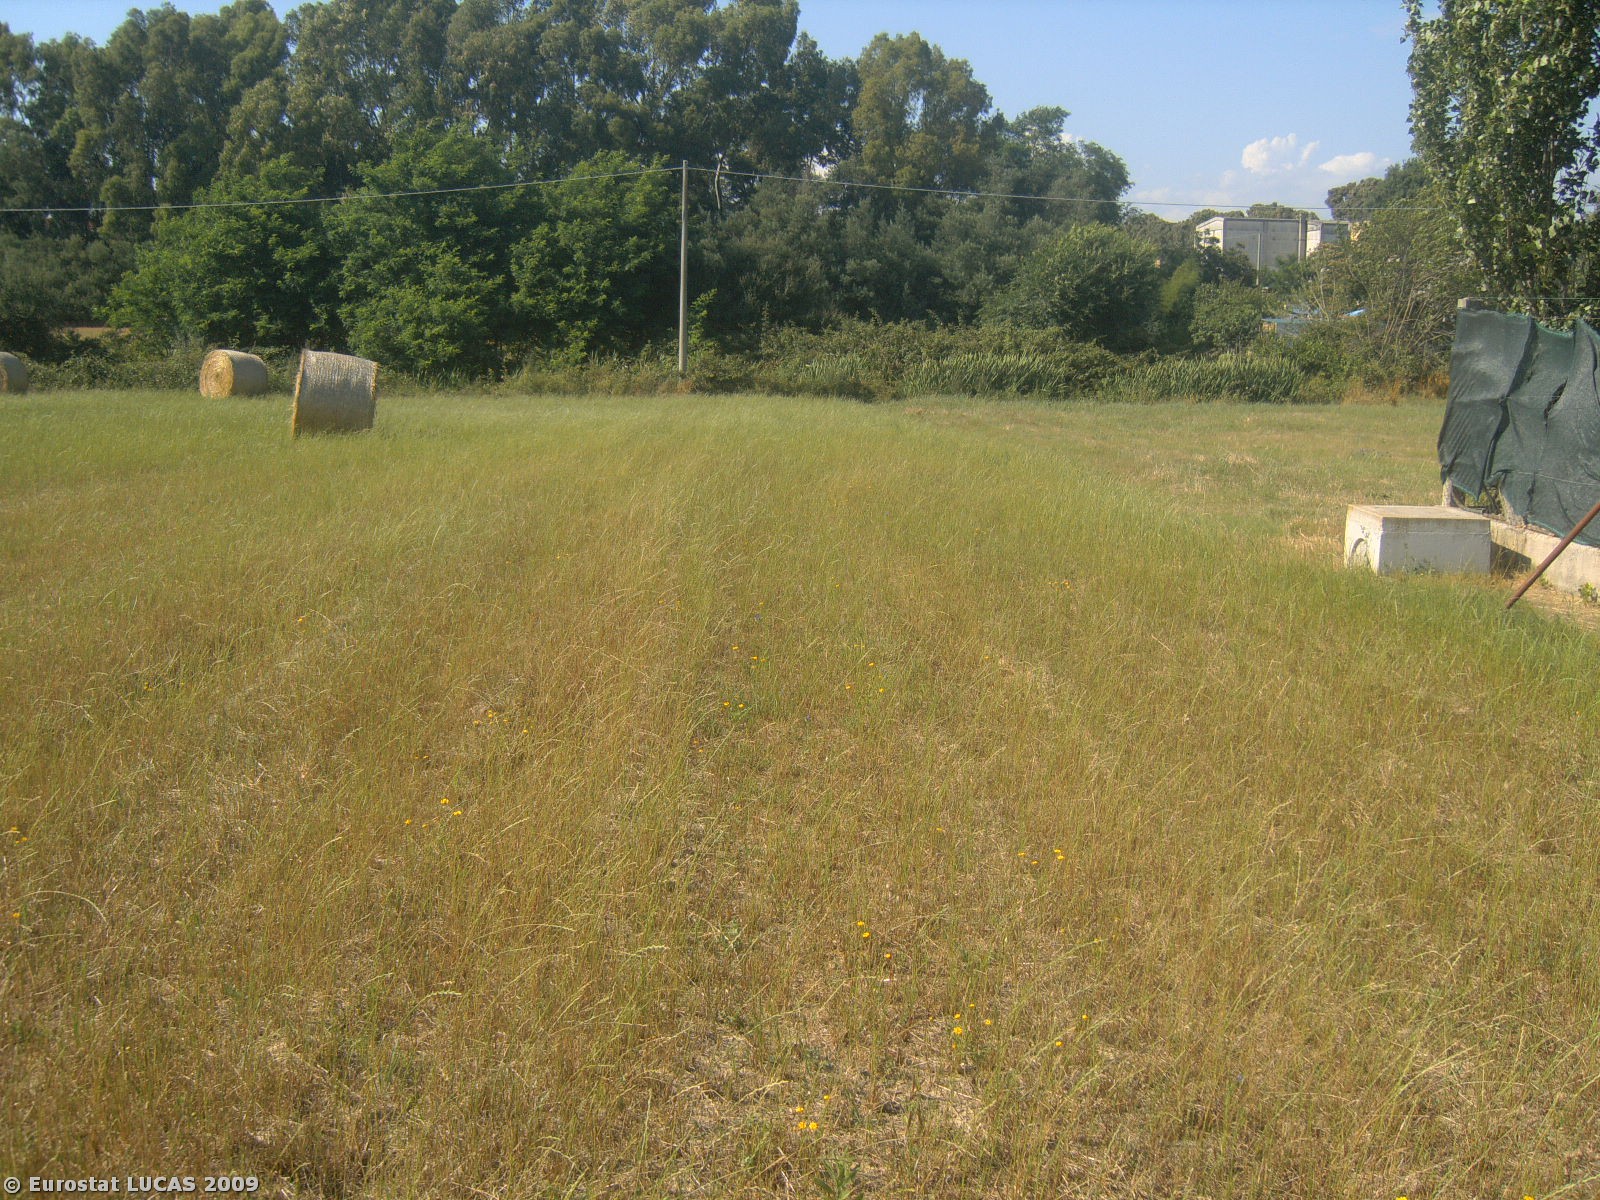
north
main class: Cropland
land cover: Temporary grasslands
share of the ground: 25 - 50 %
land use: Agriculture (excluding fallow land and kitchen gardens)
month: June
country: IT
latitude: 41.4588
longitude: 12.7783
